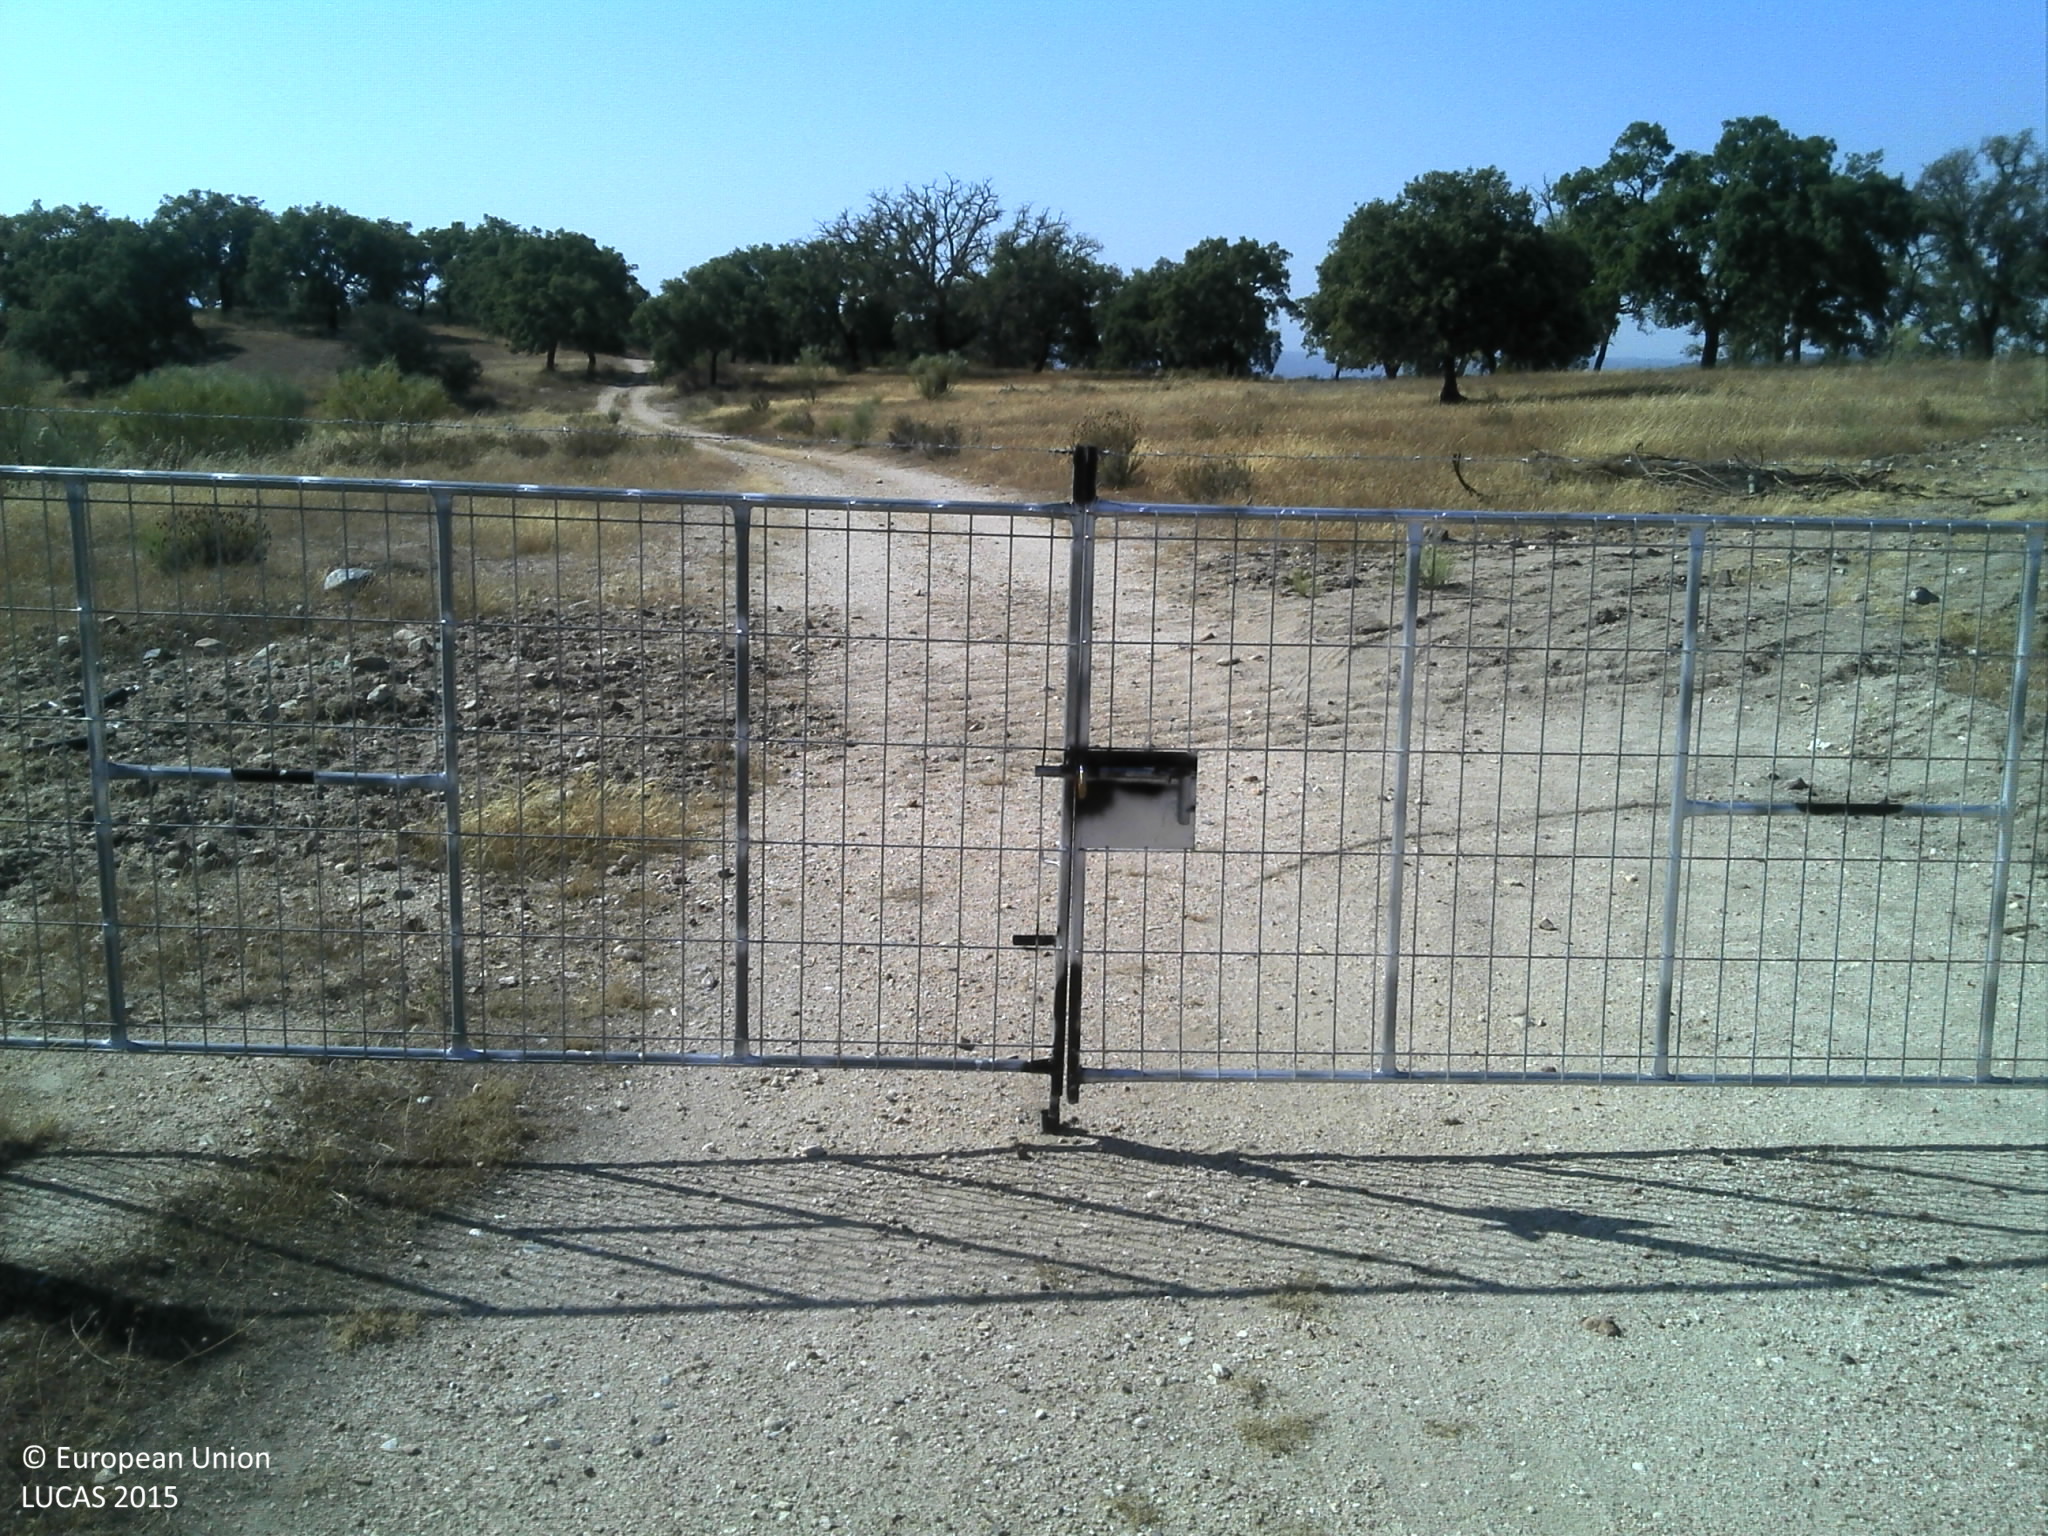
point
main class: Woodland
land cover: Broadleaved woodland
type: broadleaved evergreen forest
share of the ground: 25 - 50 %
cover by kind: herbaceous plants 55 %, broadleaved forest trees 45 %
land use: Forestry
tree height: > 5 m
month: June
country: PT
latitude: 39.7234
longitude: -7.3483
